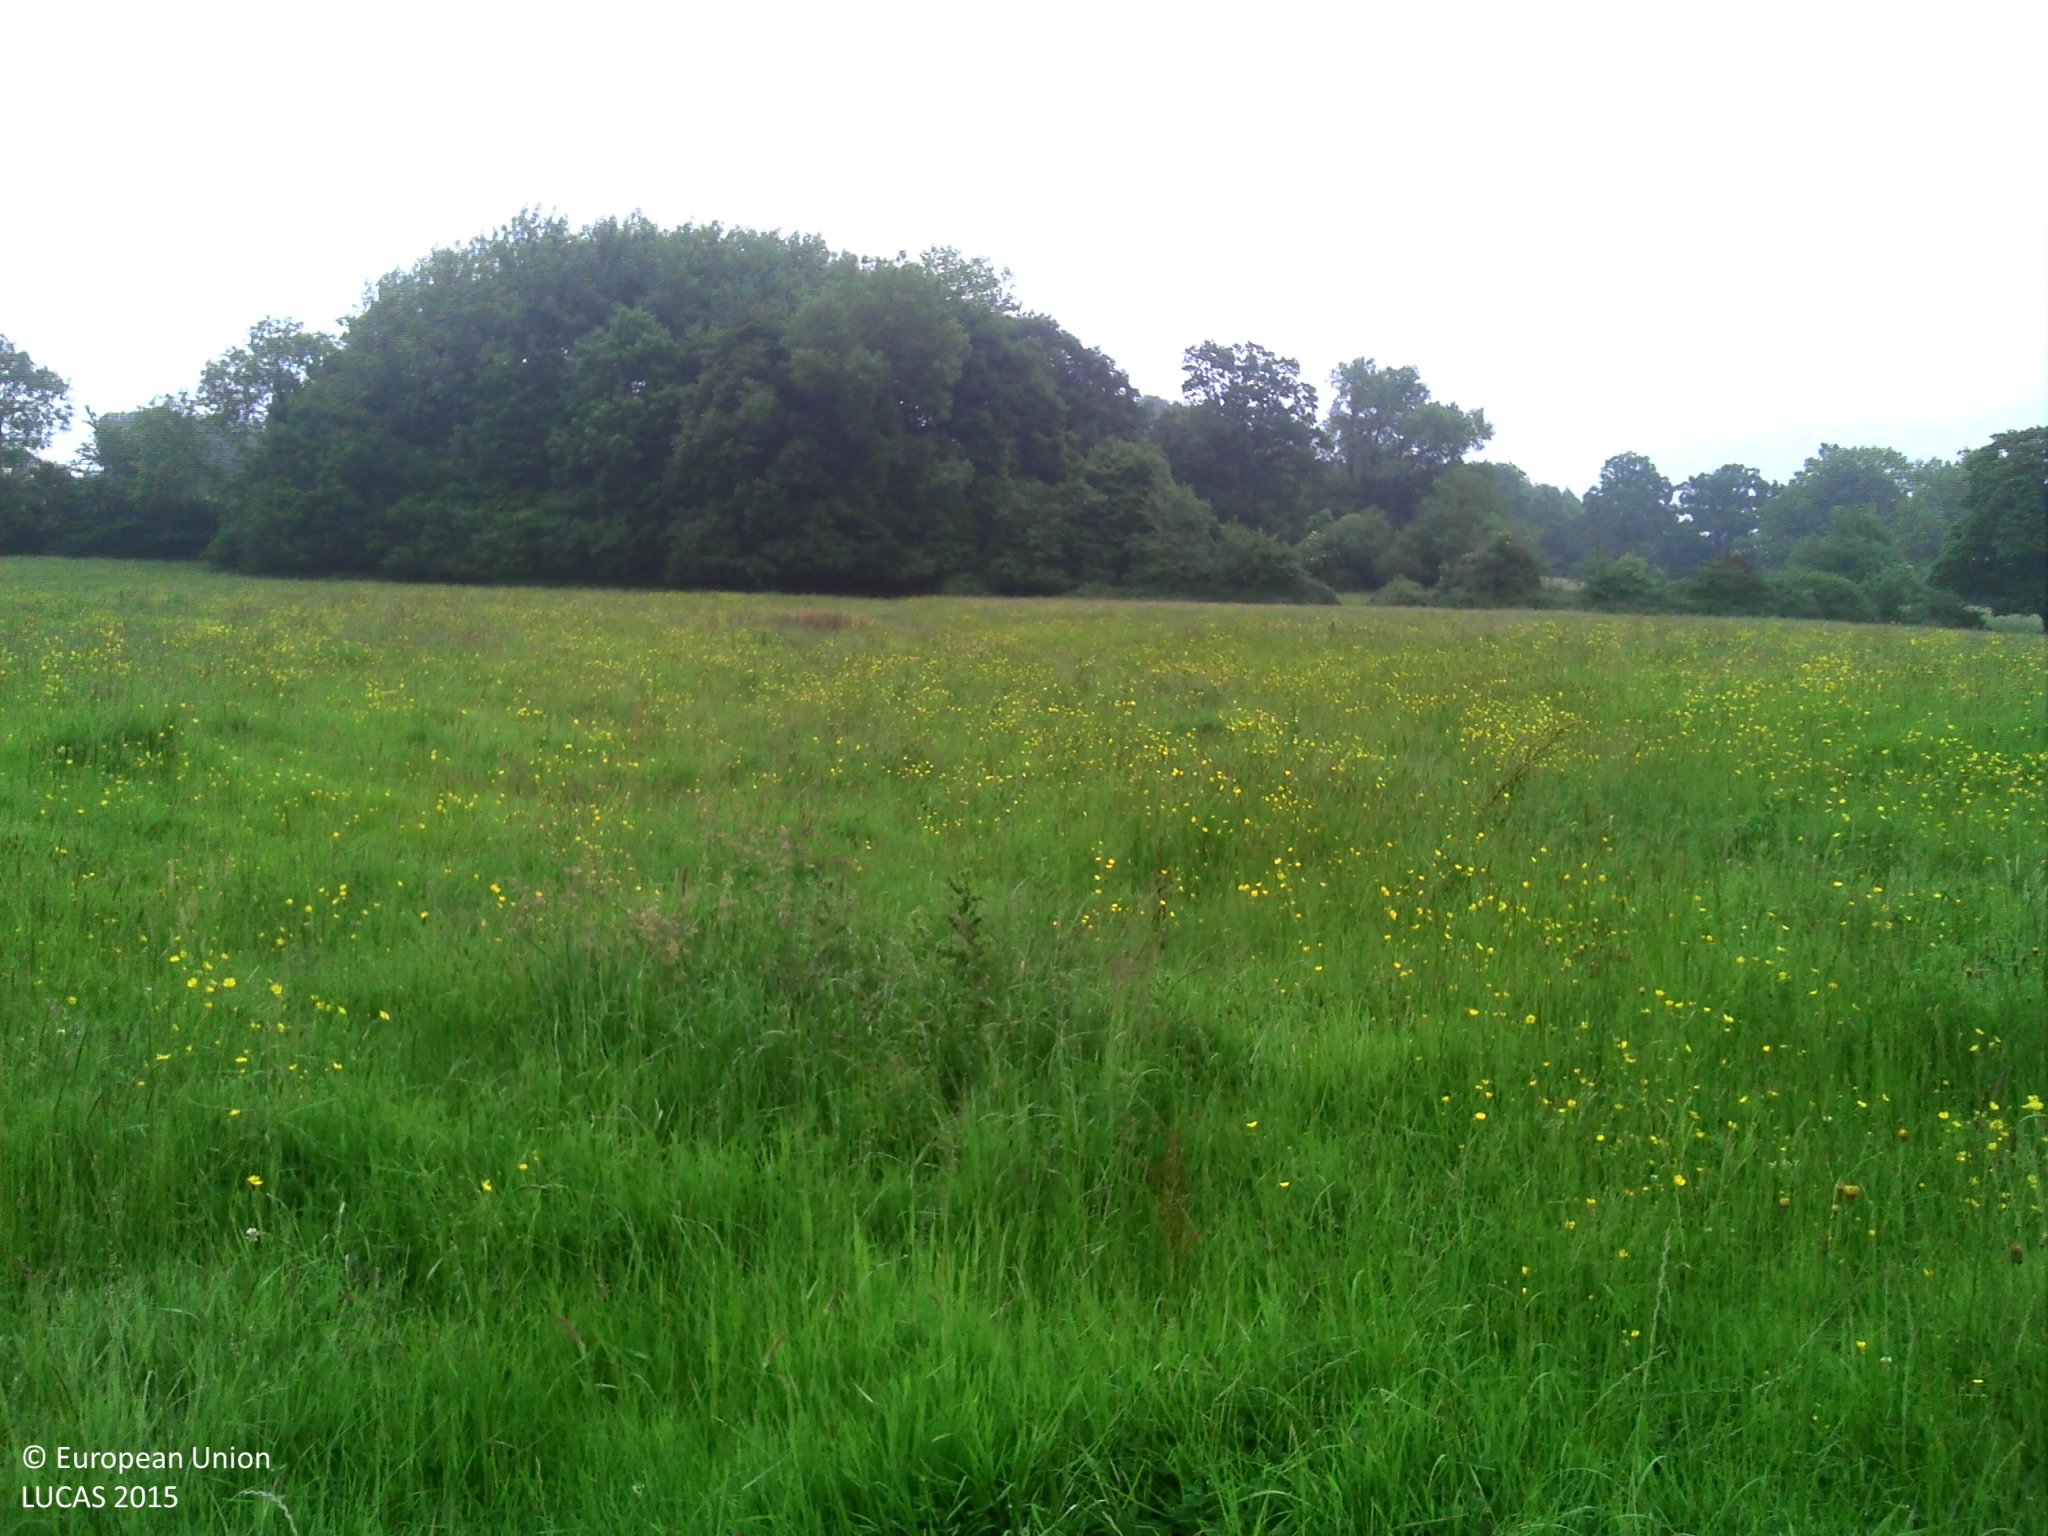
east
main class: Grassland
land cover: Grassland without tree/shrub cover
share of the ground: > 75 %
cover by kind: herbaceous plants 100 %
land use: Agriculture (excluding fallow land and kitchen gardens)
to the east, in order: Grassland without tree/shrub cover; Broadleaved woodland; Spontaneously vegetated surfaces; Grassland without tree/shrub cover
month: June
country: FR
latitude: 49.2549
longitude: 0.0079
